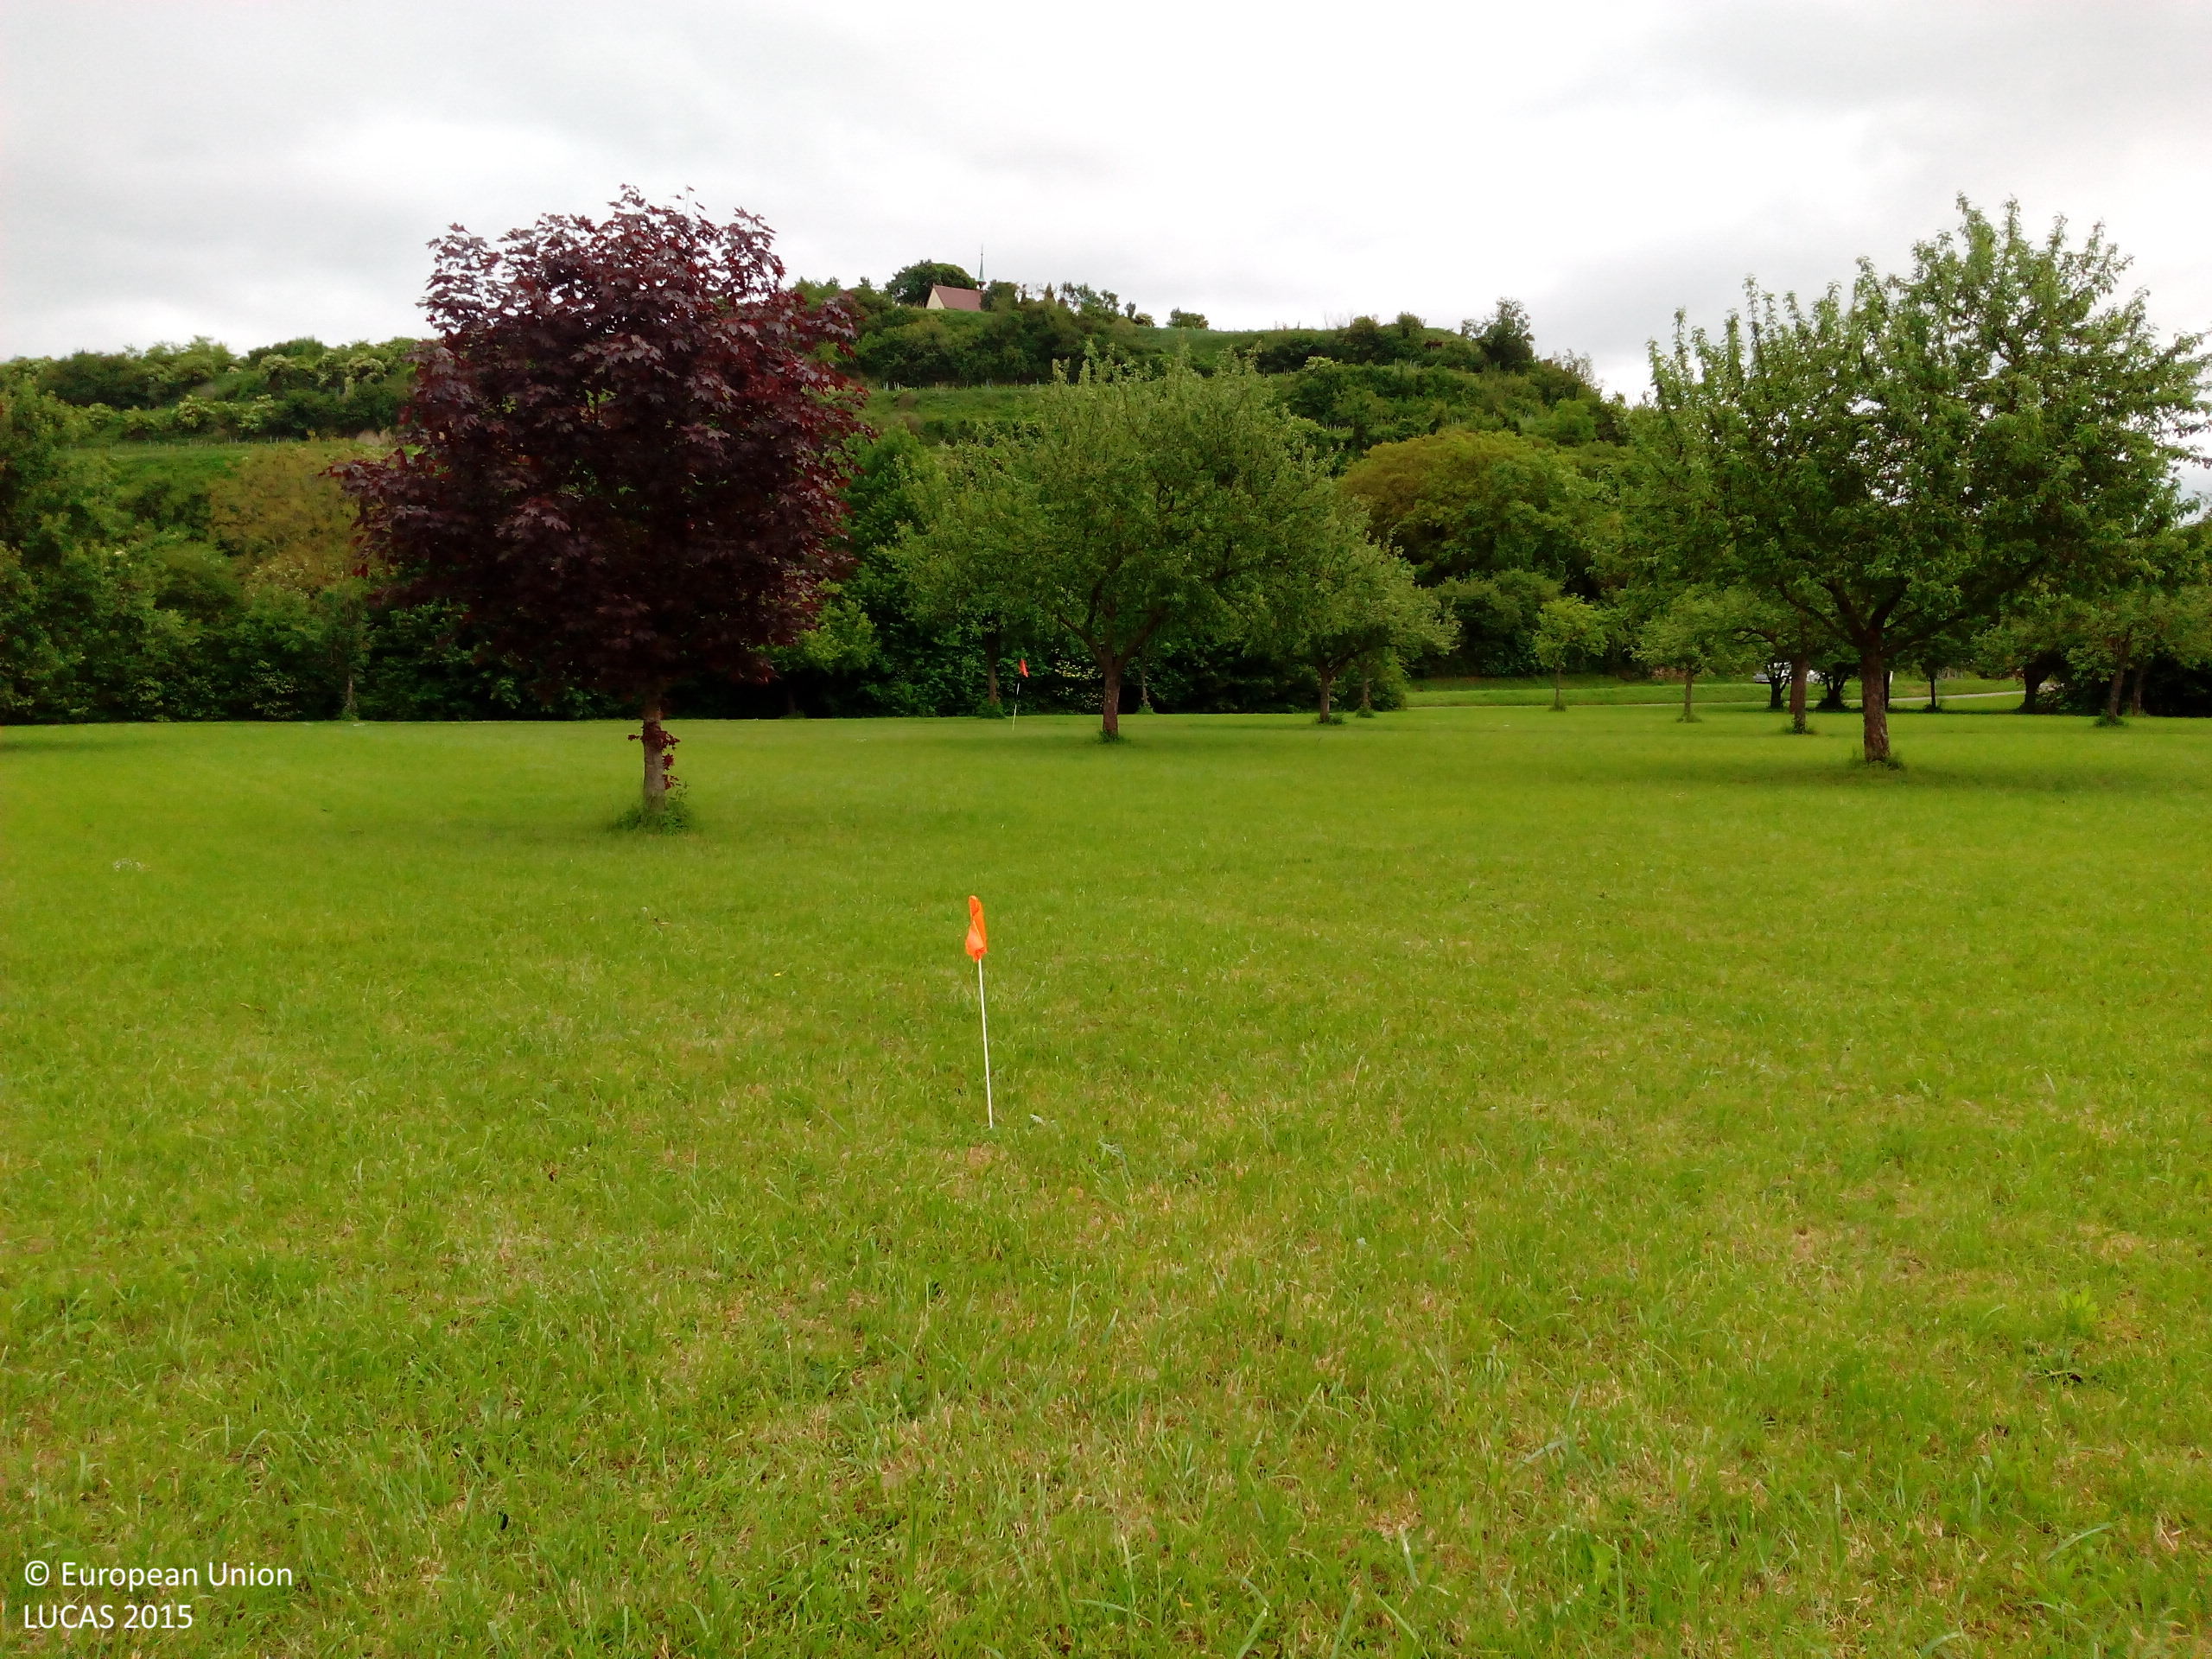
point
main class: Grassland
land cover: Grassland without tree/shrub cover
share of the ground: > 75 %
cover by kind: herbaceous plants 100 %
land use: Sport
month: May
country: DE
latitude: 47.9652
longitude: 7.6841
